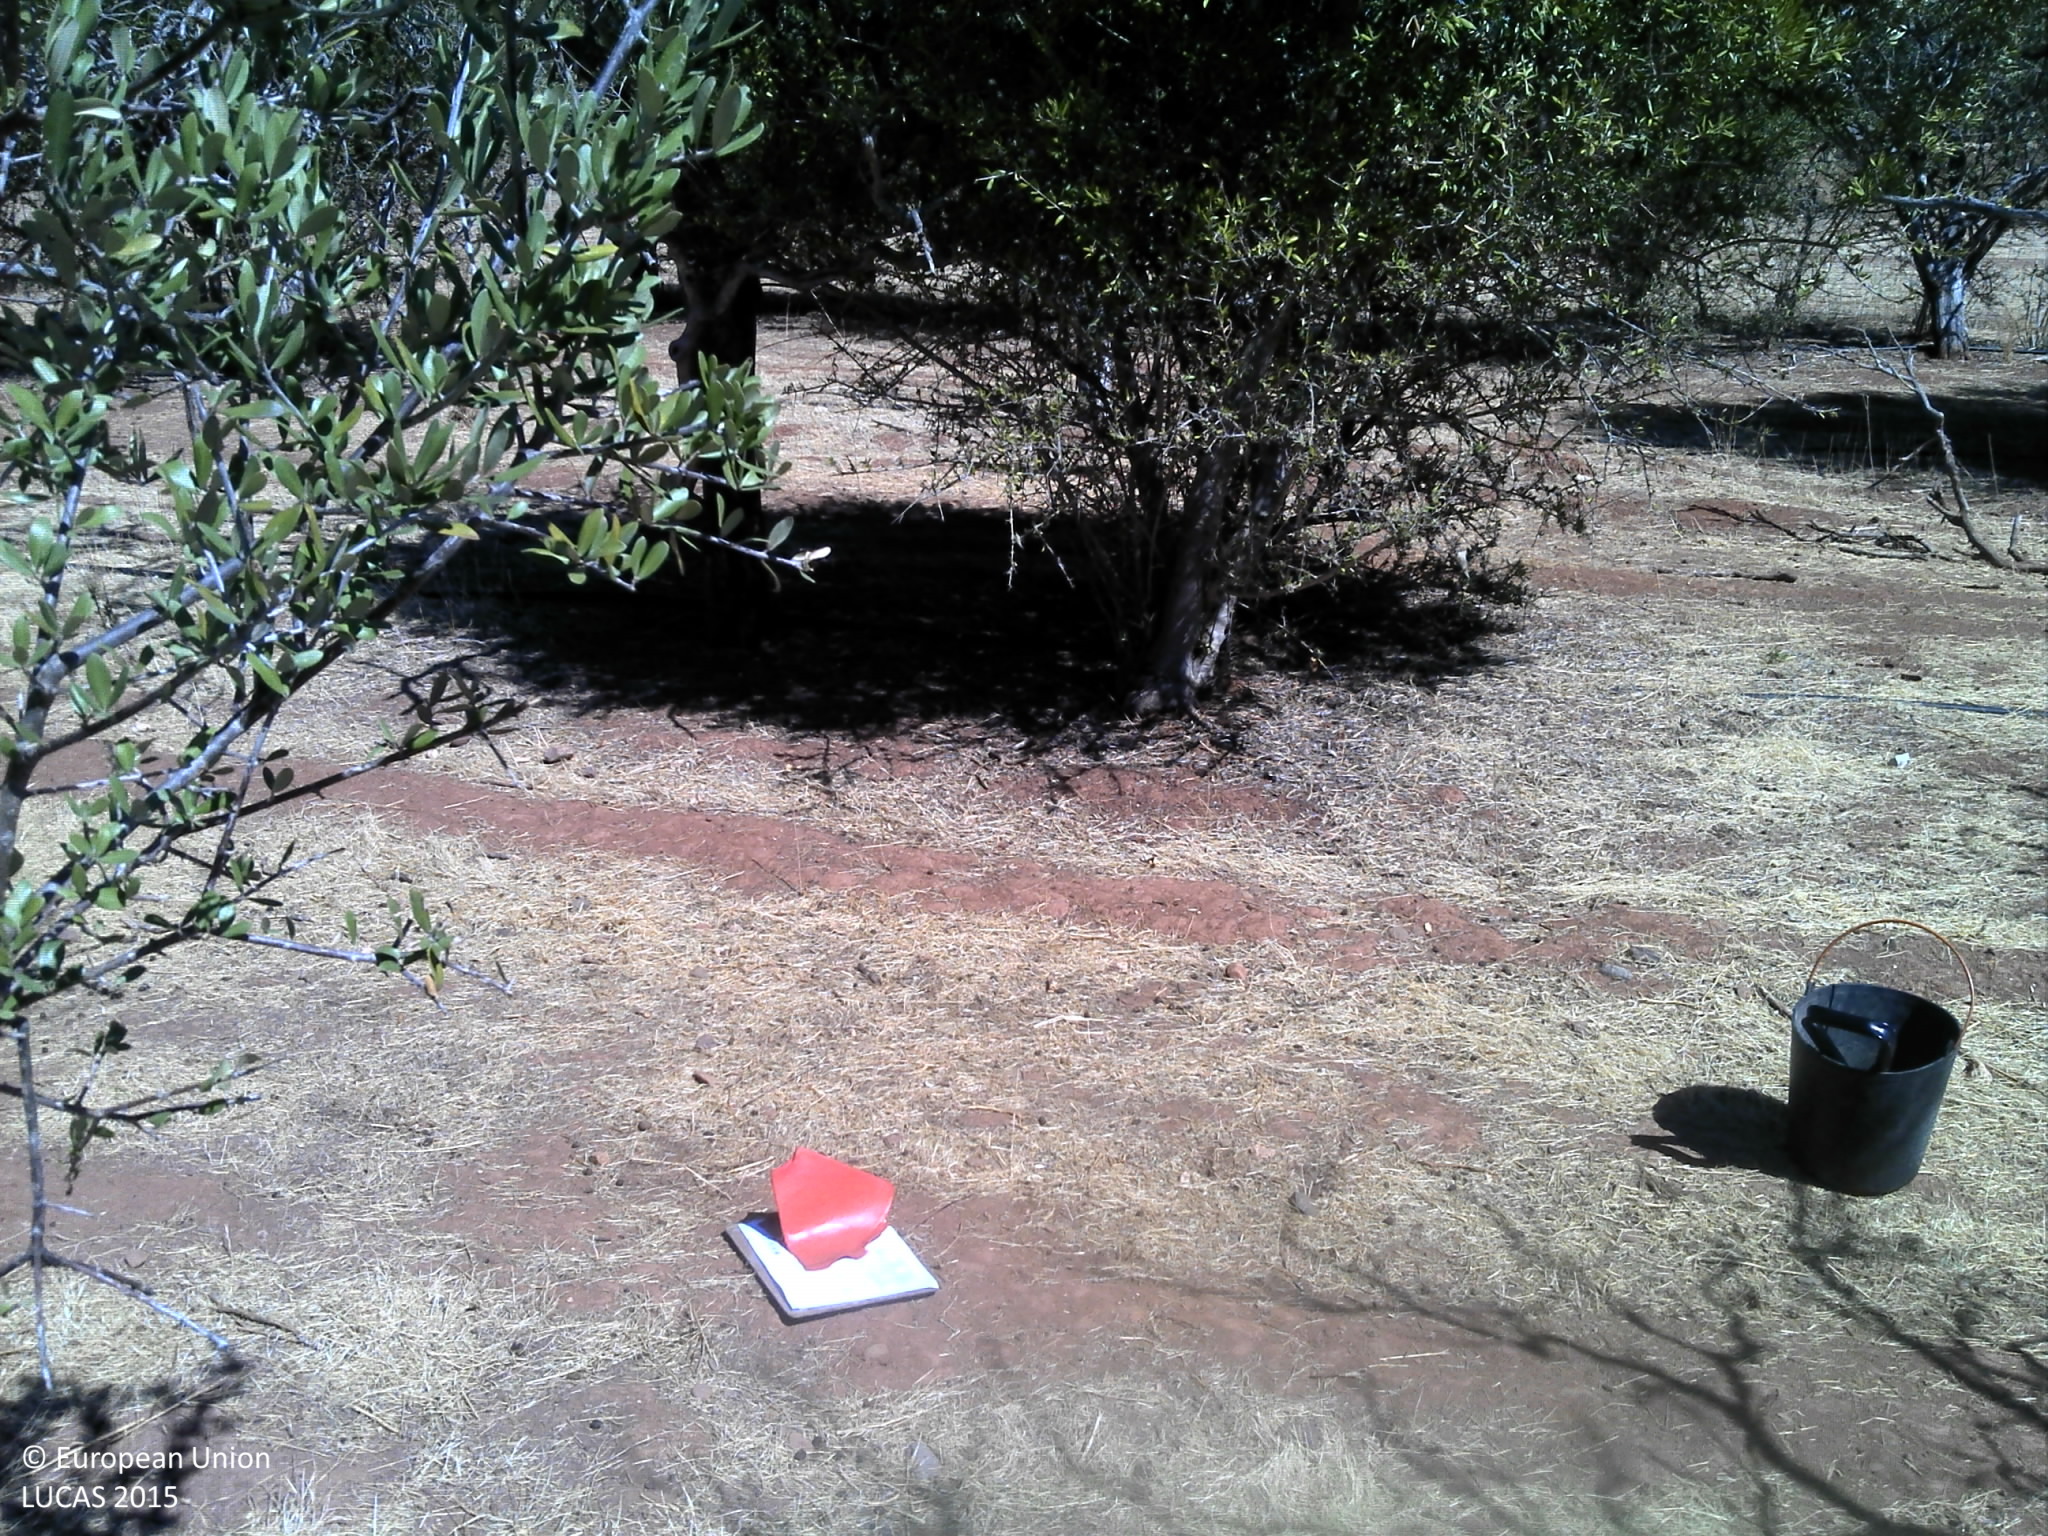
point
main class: Cropland
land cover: Olive groves
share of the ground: 50 - 75 %
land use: Agriculture (excluding fallow land and kitchen gardens)
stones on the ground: < 10 %
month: September
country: PT
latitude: 37.1819
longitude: -8.1867
